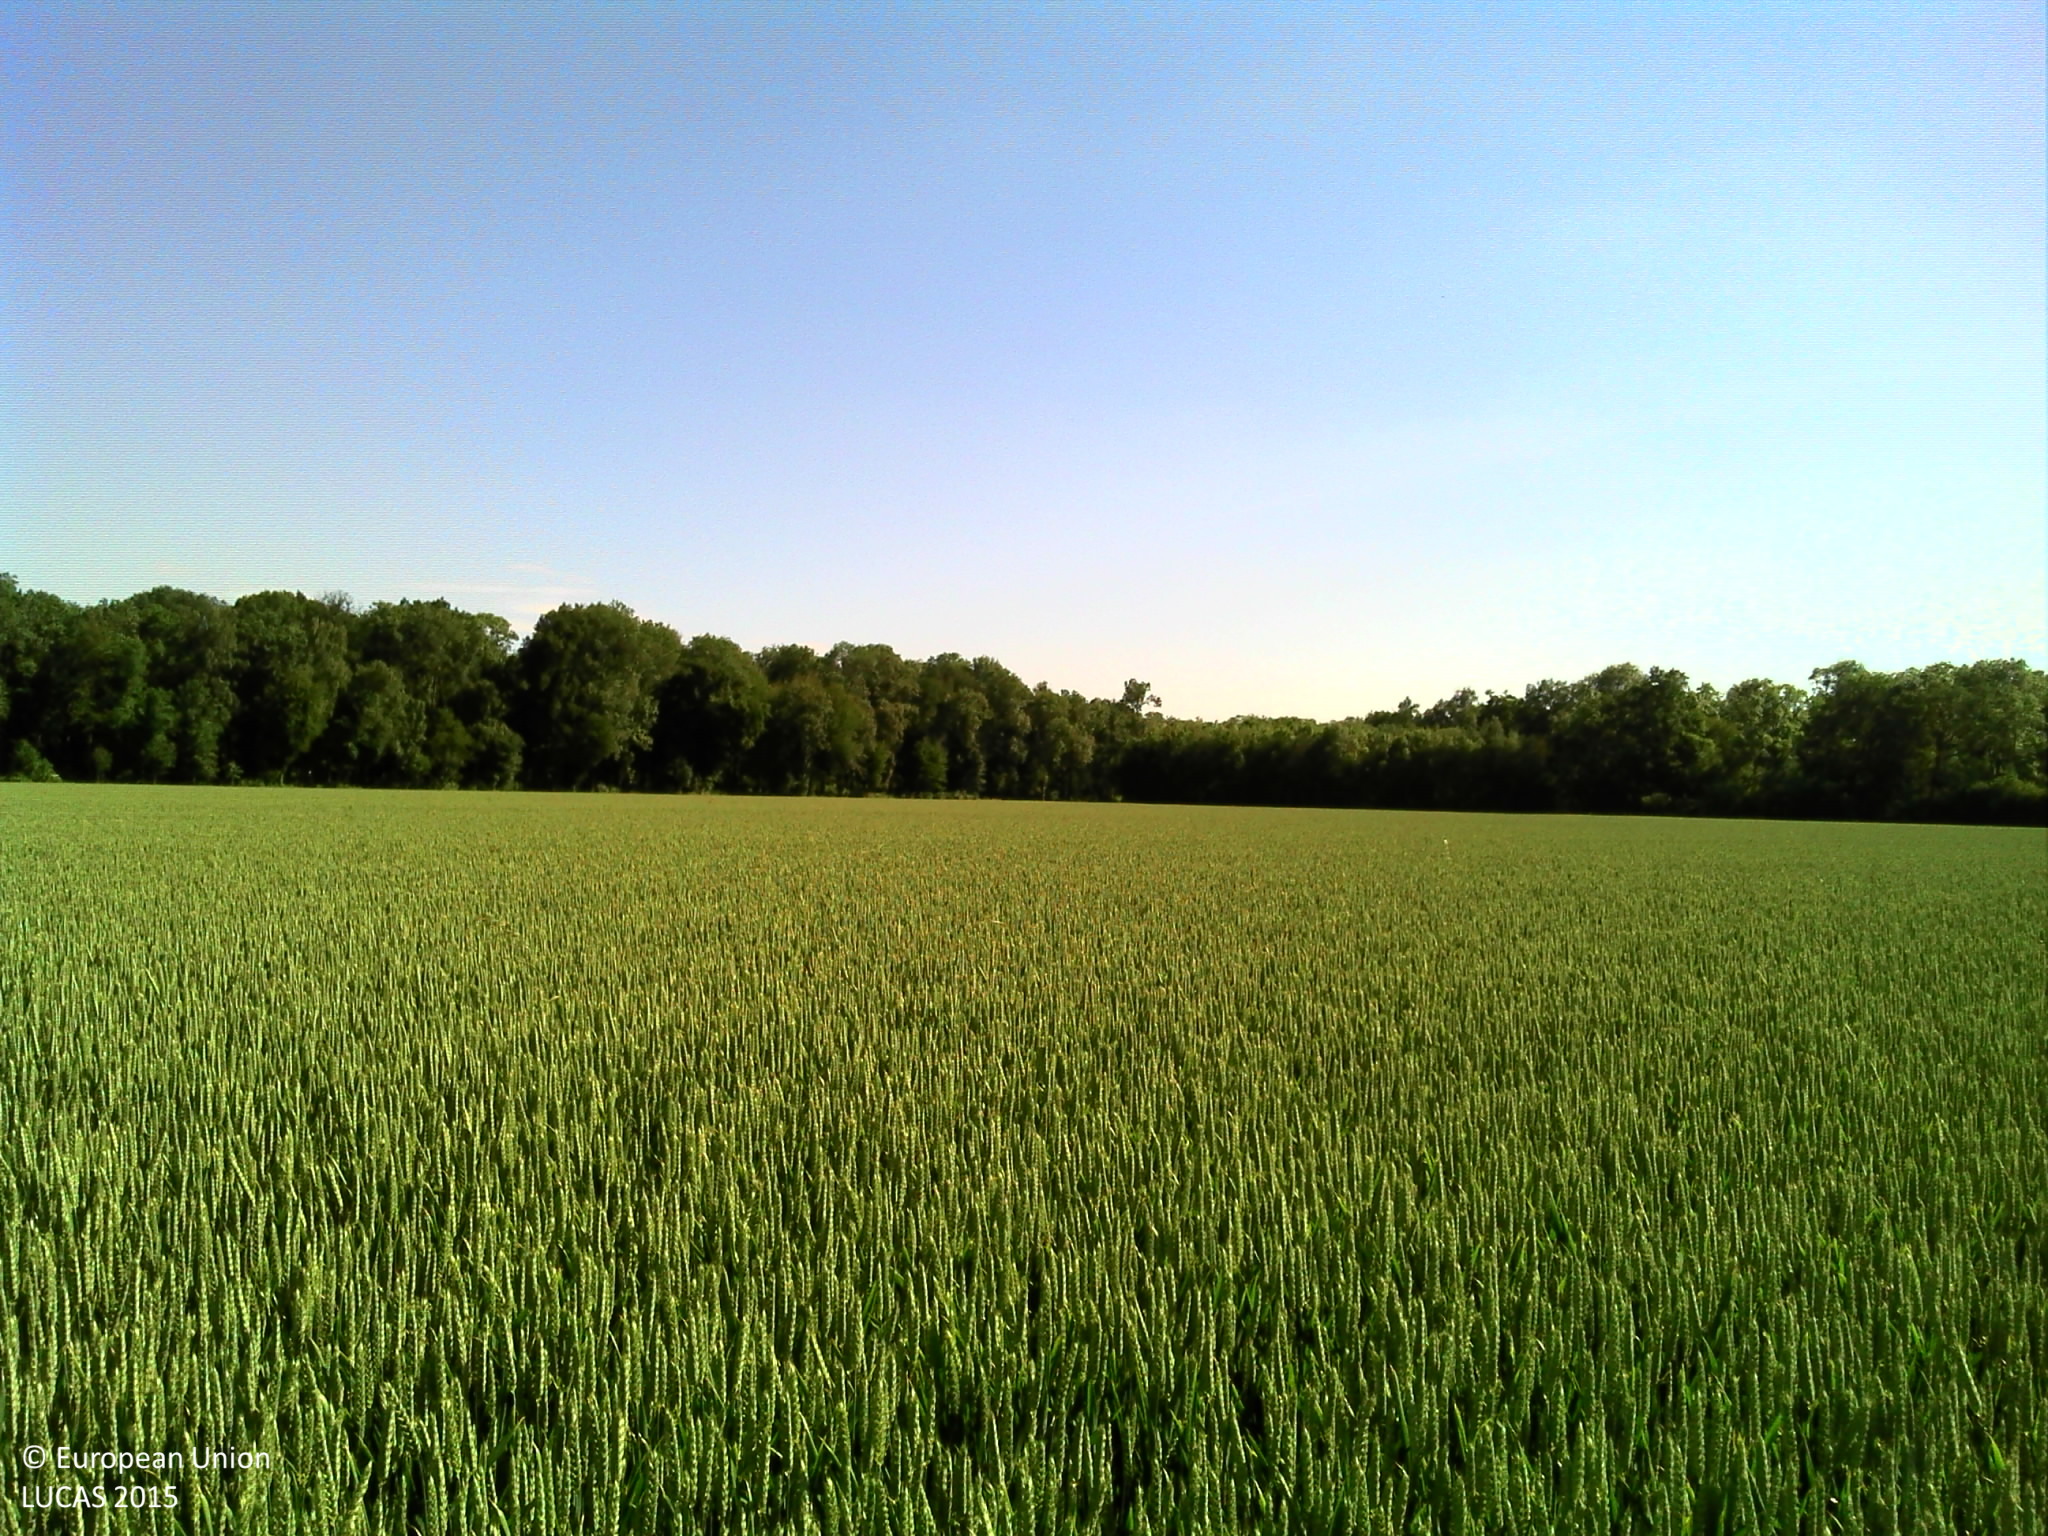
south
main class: Cropland
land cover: Common wheat
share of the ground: > 75 %
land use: Agriculture (excluding fallow land and kitchen gardens)
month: June
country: FR
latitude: 47.2479
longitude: 5.0725
